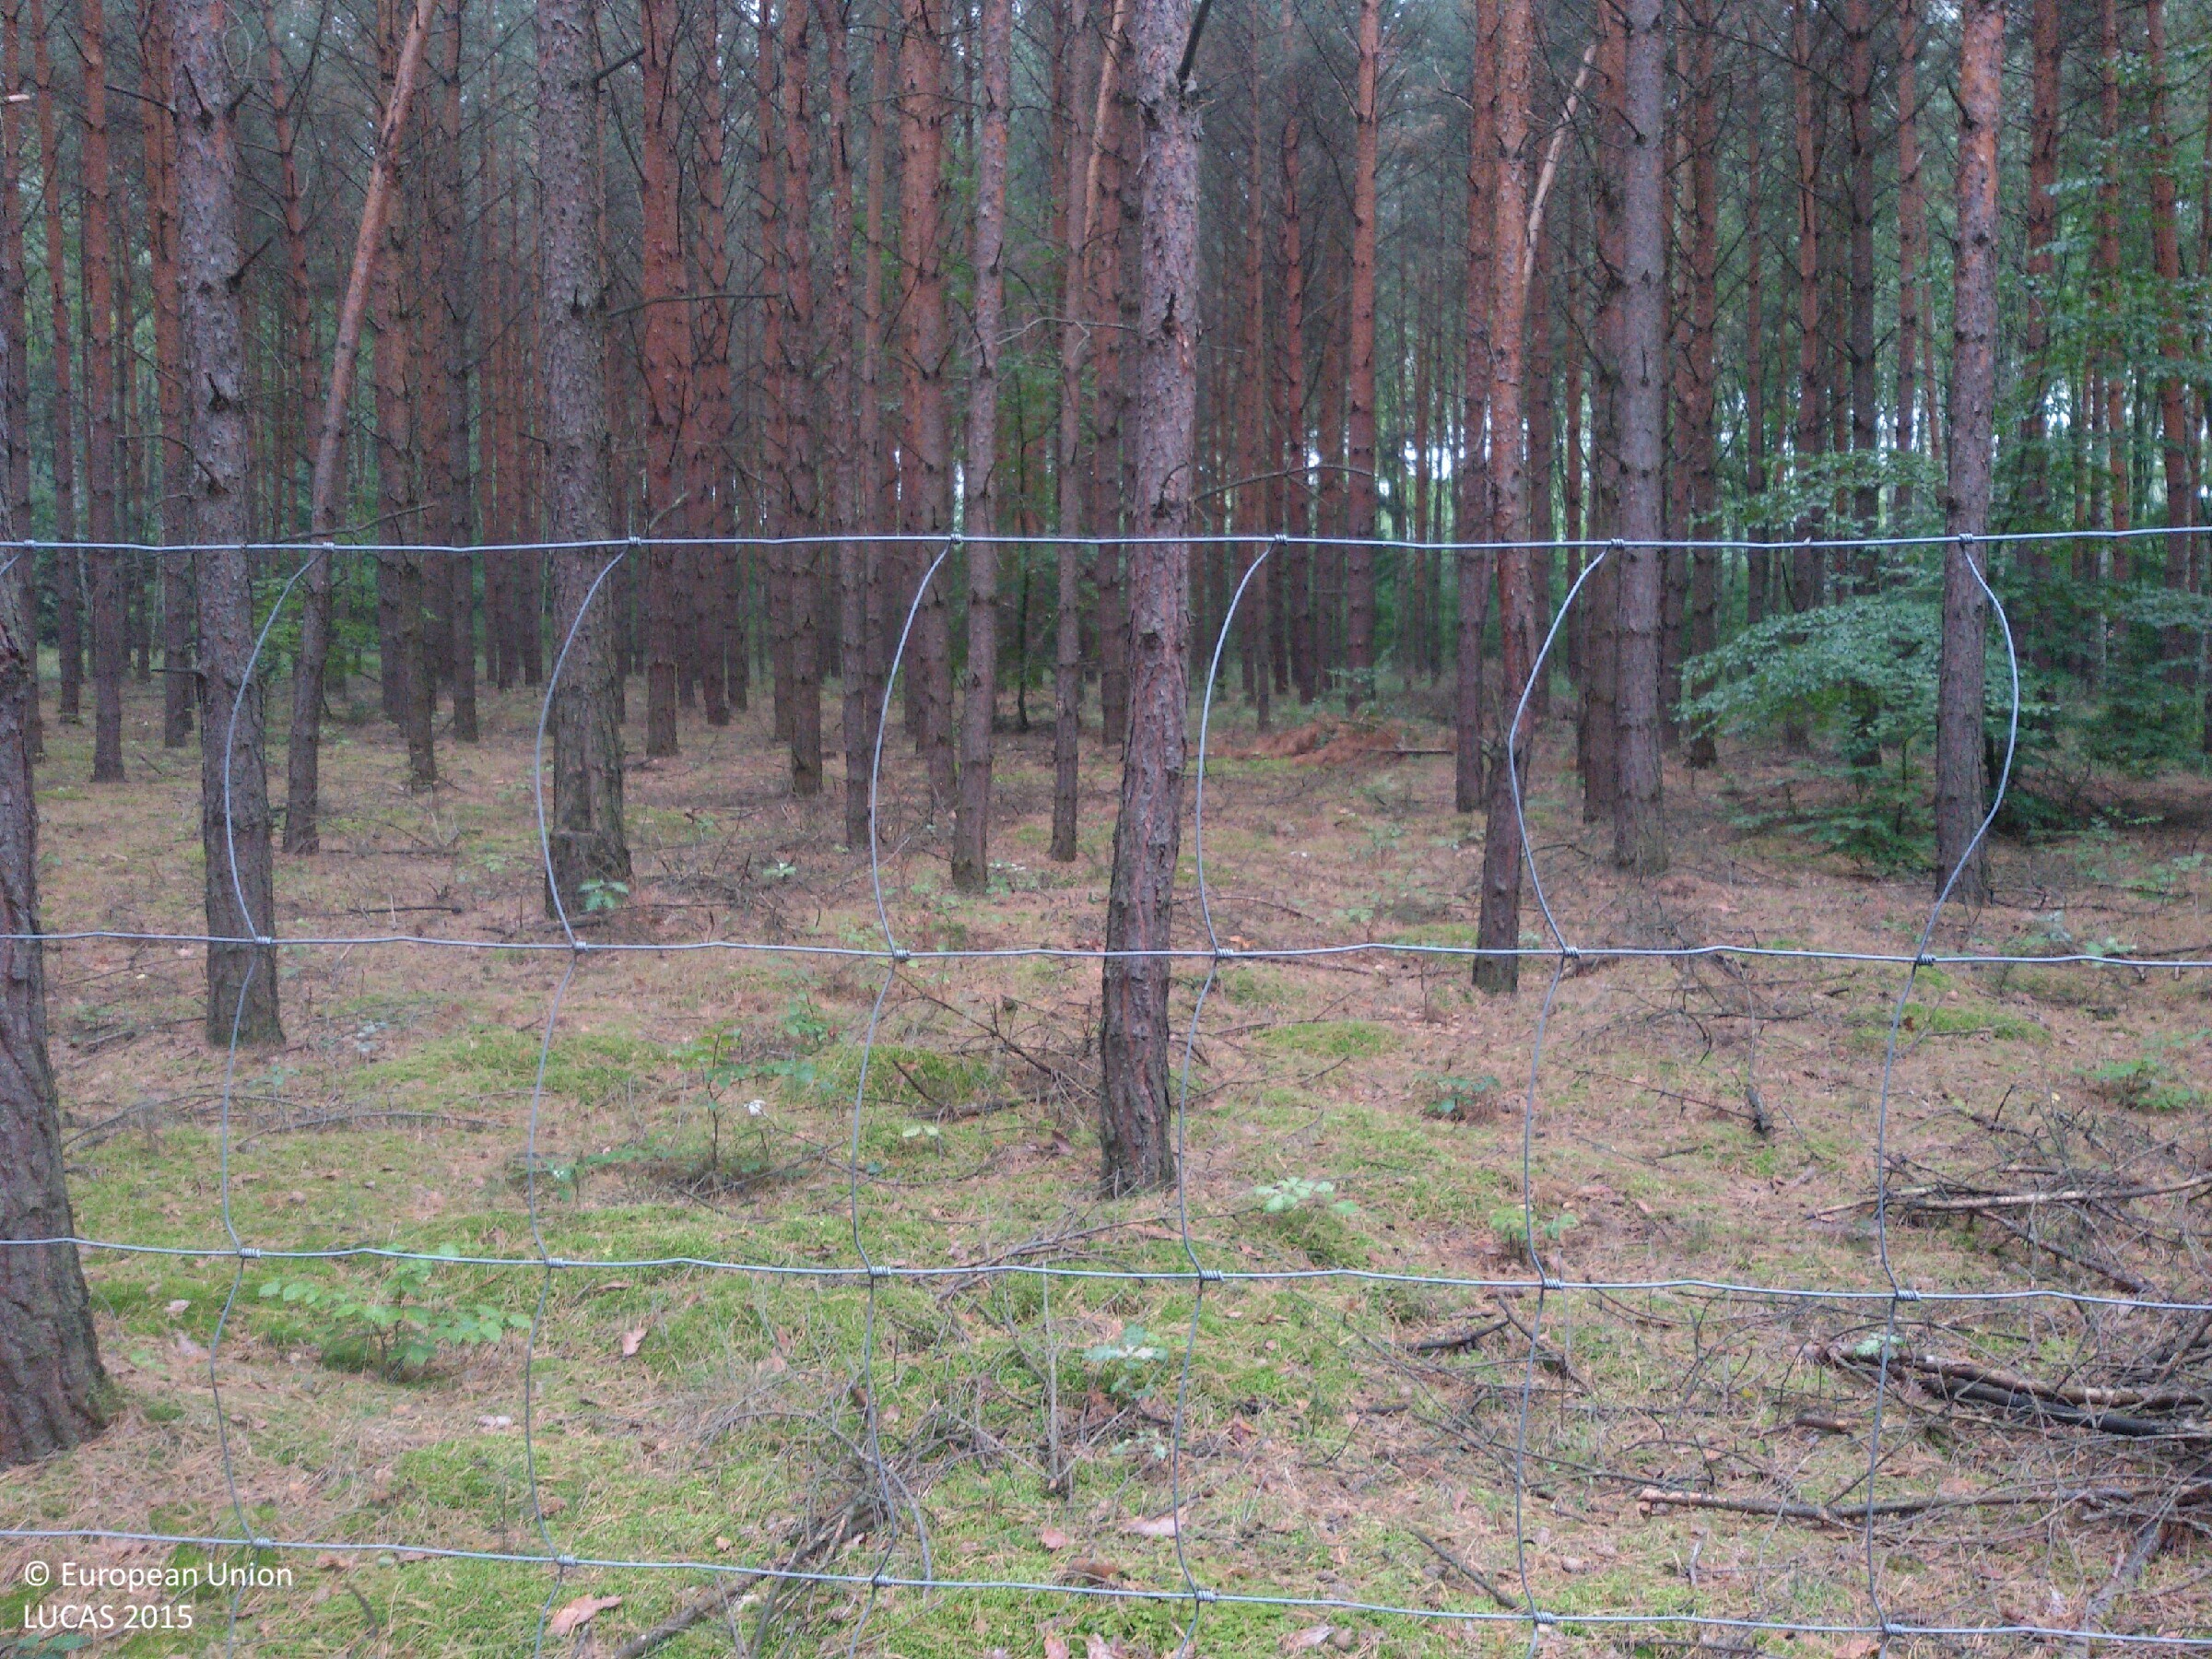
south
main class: Woodland
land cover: Pine dominated coniferous woodland
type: hemiboreal forest and nemoral coniferous forest and mixed broadleaved-coniferous forest
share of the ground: > 75 %
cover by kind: coniferous forest trees 85 %, lichens and mosses 10 %, broadleaved forest trees 5 %
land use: Forestry
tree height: > 5 m
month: September
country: PL
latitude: 51.7271
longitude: 14.6784
